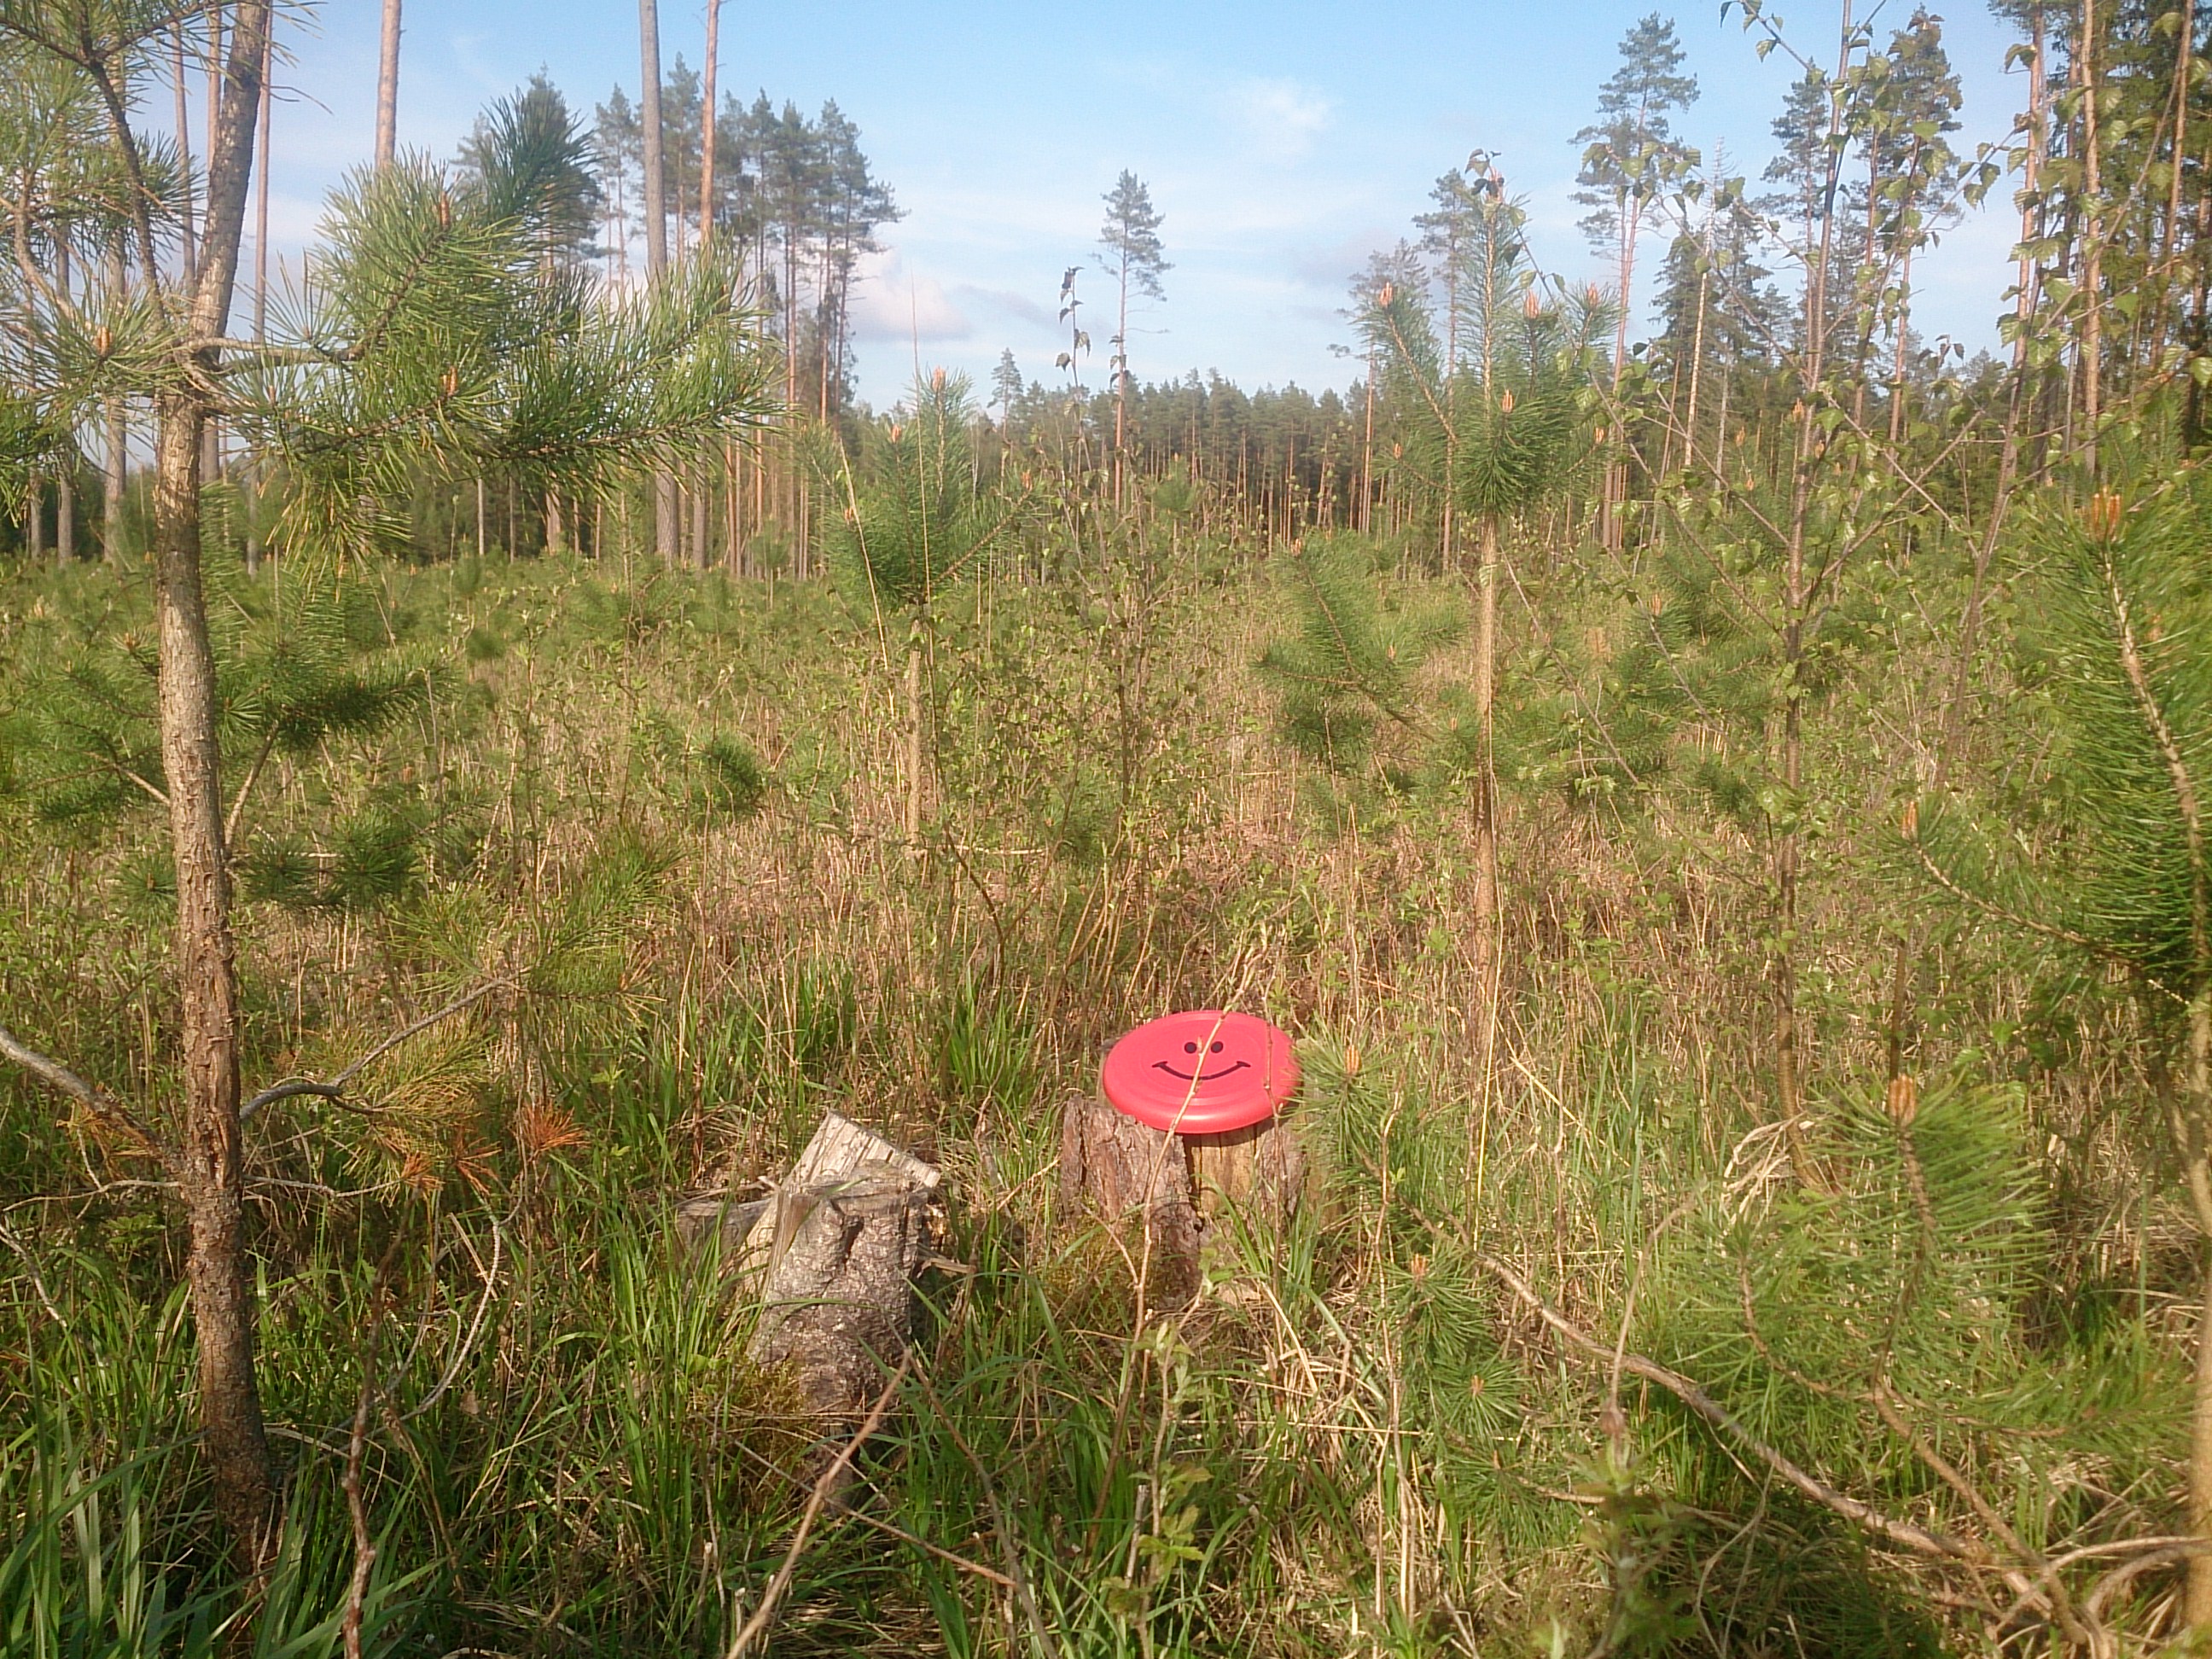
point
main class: Woodland
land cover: Pine dominated coniferous woodland
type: hemiboreal forest and nemoral coniferous forest and mixed broadleaved-coniferous forest
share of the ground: > 75 %
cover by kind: coniferous forest trees 75 %, shrubs 25 %
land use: Forestry
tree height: < 5 m
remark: Nursery
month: May
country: LV
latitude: 56.7392
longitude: 24.0967
